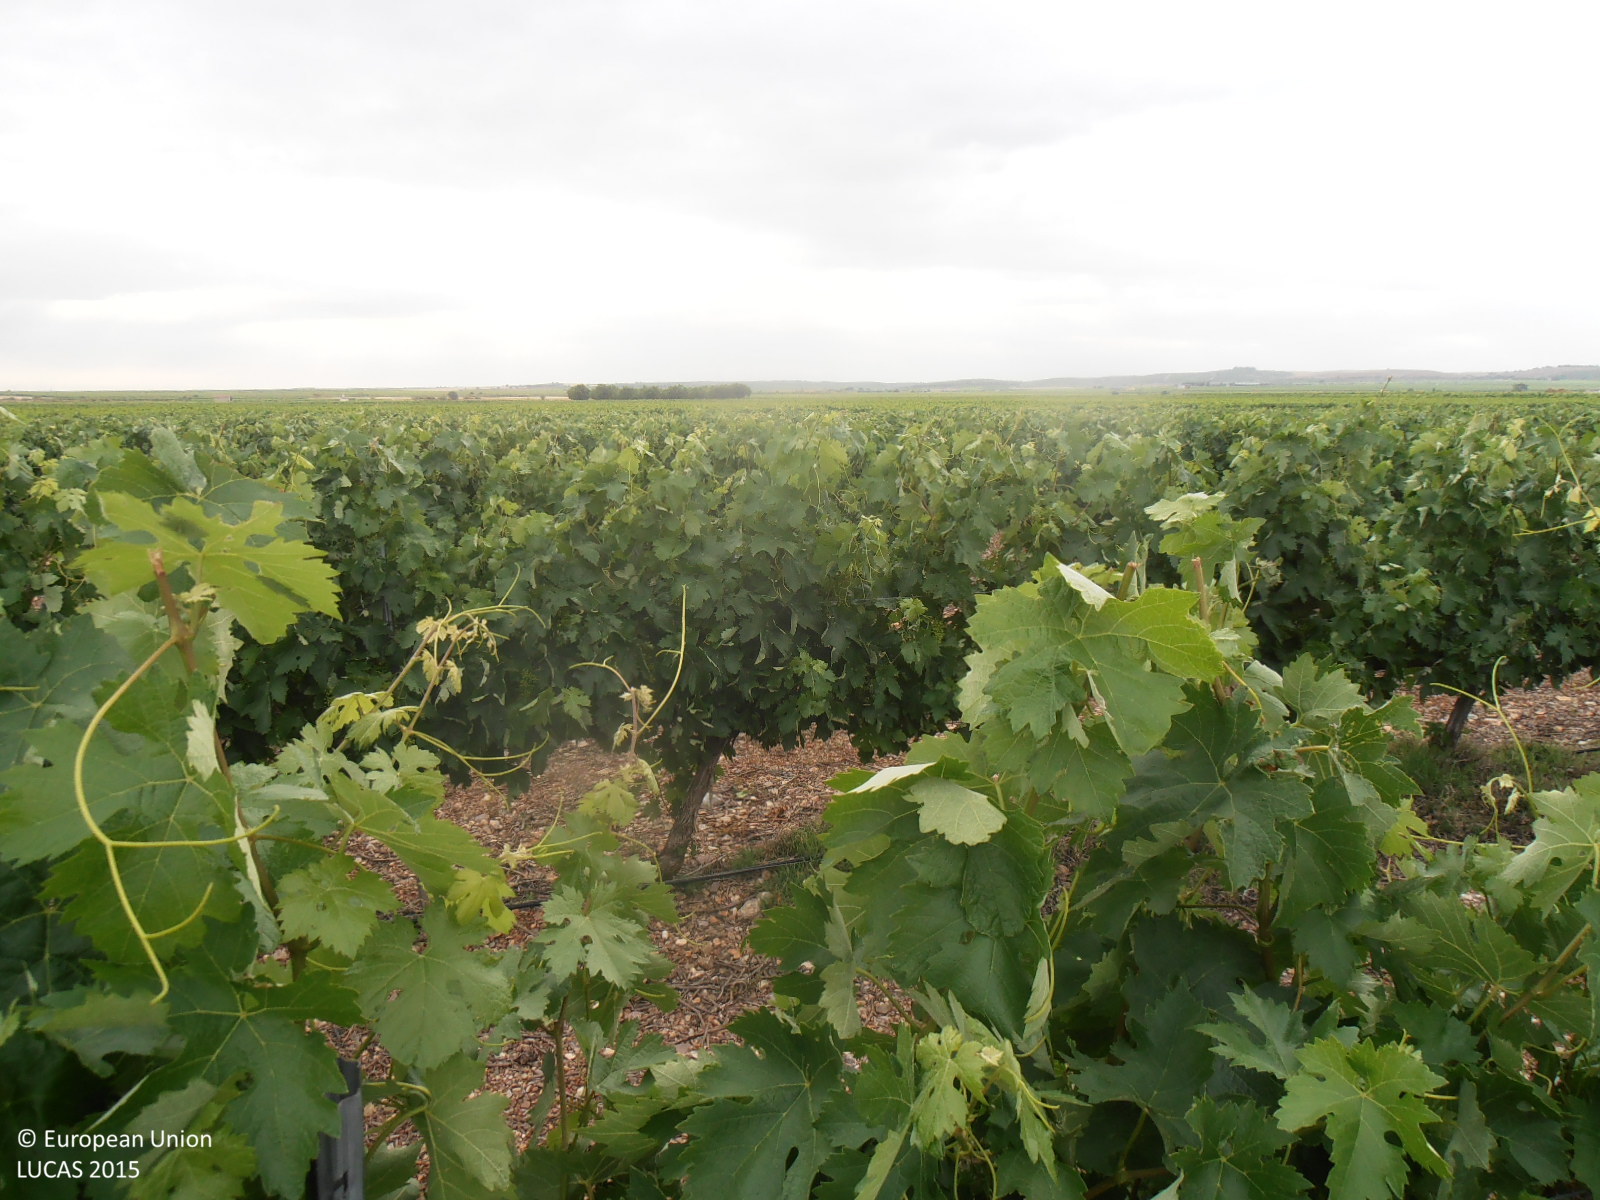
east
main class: Cropland
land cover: Vineyards
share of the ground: 10 - 25 %
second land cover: Other bare soil
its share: > 75 %
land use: Agriculture (excluding fallow land and kitchen gardens)
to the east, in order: Vineyards; Other bare soil; Tracks; Vineyards
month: June
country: ES
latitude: 41.3569
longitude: -1.1977
